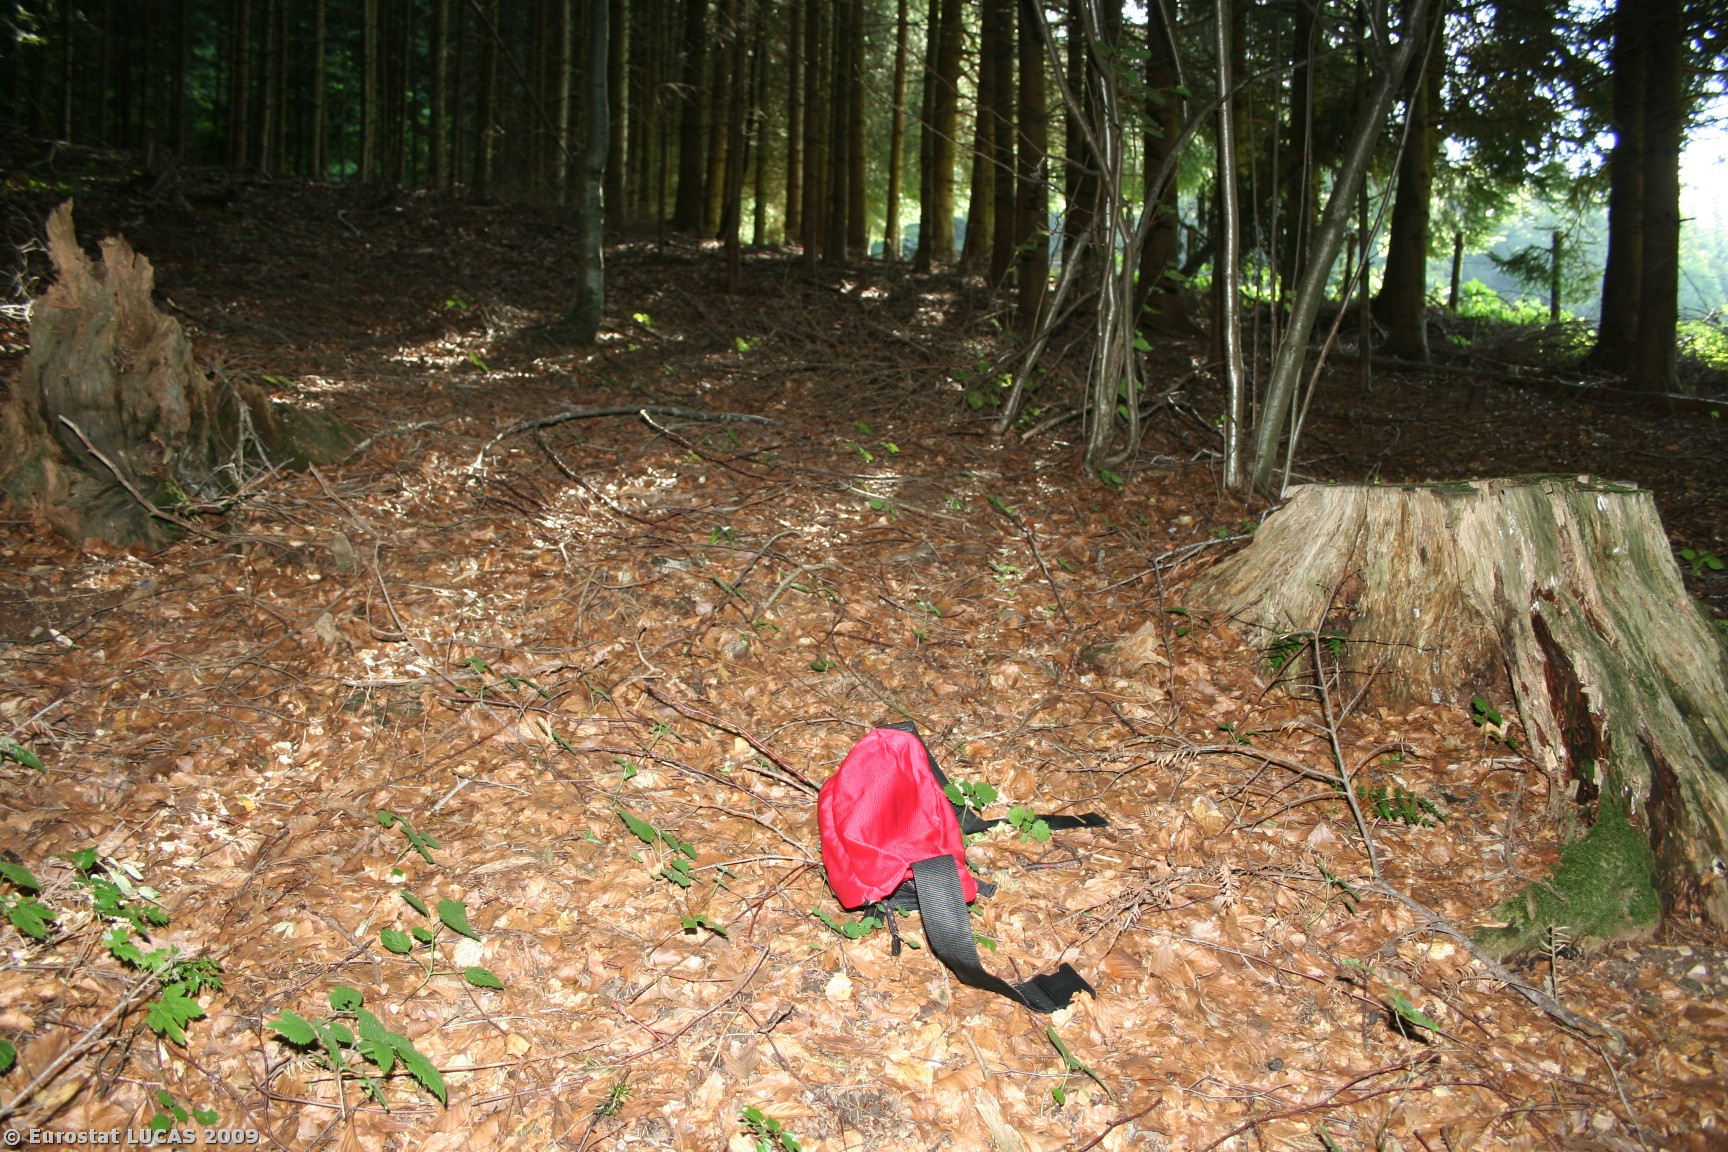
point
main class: Woodland
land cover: Mixed woodland
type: hemiboreal forest and nemoral coniferous forest and mixed broadleaved-coniferous forest
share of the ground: > 75 %
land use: Forestry
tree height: > 5 m
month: August
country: AT
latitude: 47.7085
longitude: 13.2106
